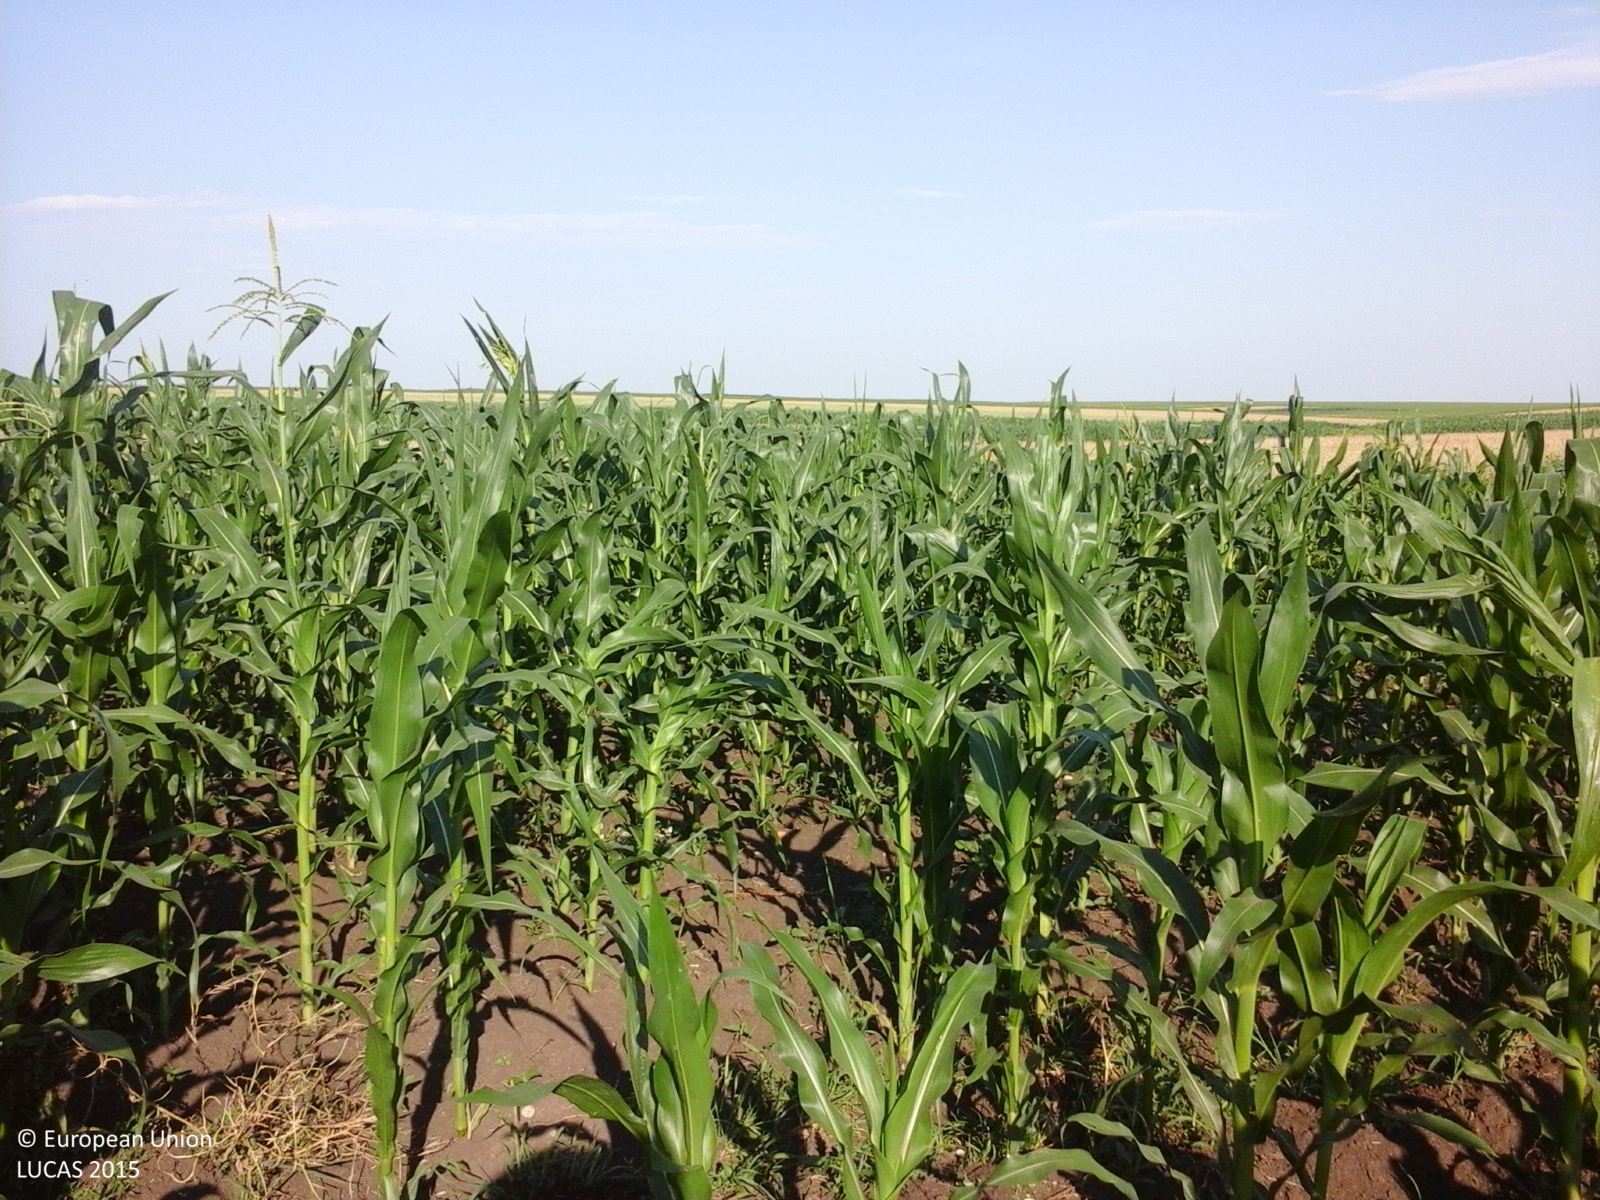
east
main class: Cropland
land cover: Maize
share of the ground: > 75 %
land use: Agriculture (excluding fallow land and kitchen gardens)
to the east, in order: Maize; Grass margins; Common wheat; Maize; Common wheat; Maize; Oats
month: July
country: RO
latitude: 44.5609
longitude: 24.4357
